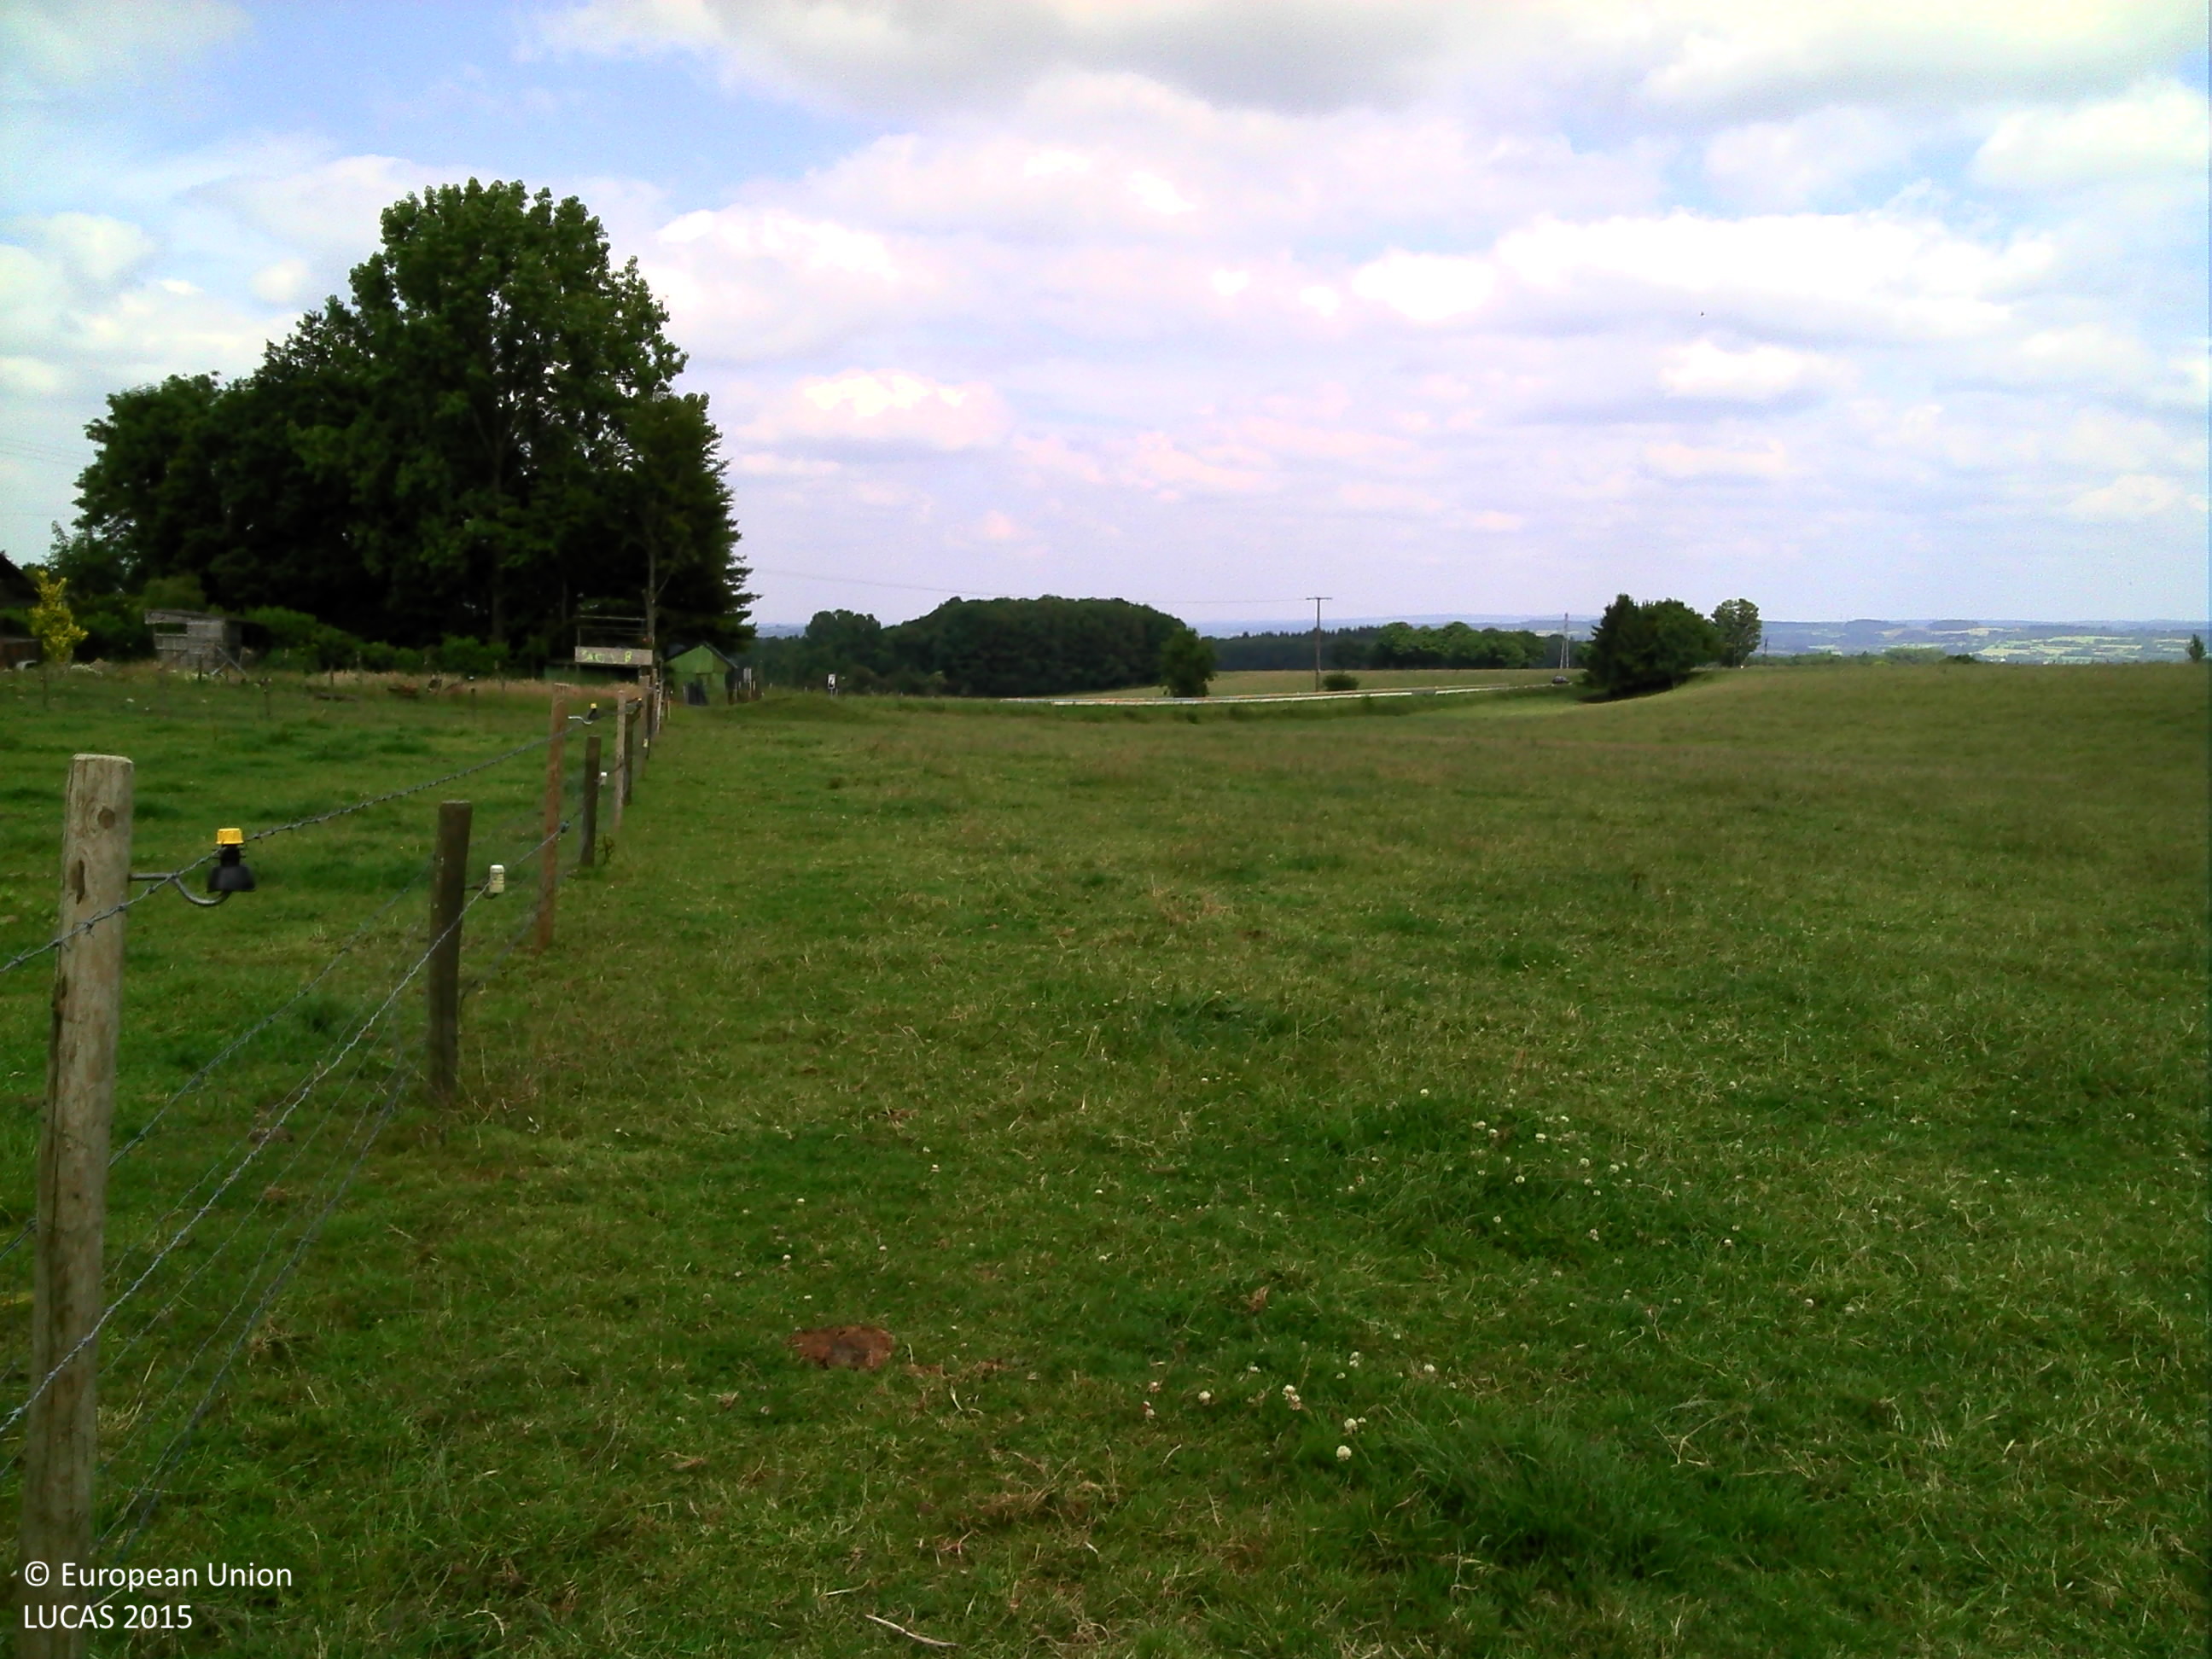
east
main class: Grassland
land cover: Grassland without tree/shrub cover
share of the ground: > 75 %
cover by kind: herbaceous plants 100 %
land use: Agriculture (excluding fallow land and kitchen gardens)
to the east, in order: Grassland without tree/shrub cover; Fences; Grassland without tree/shrub cover; Electric lines; Grassland without tree/shrub cover
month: June
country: BE
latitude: 50.4368
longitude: 5.4787
